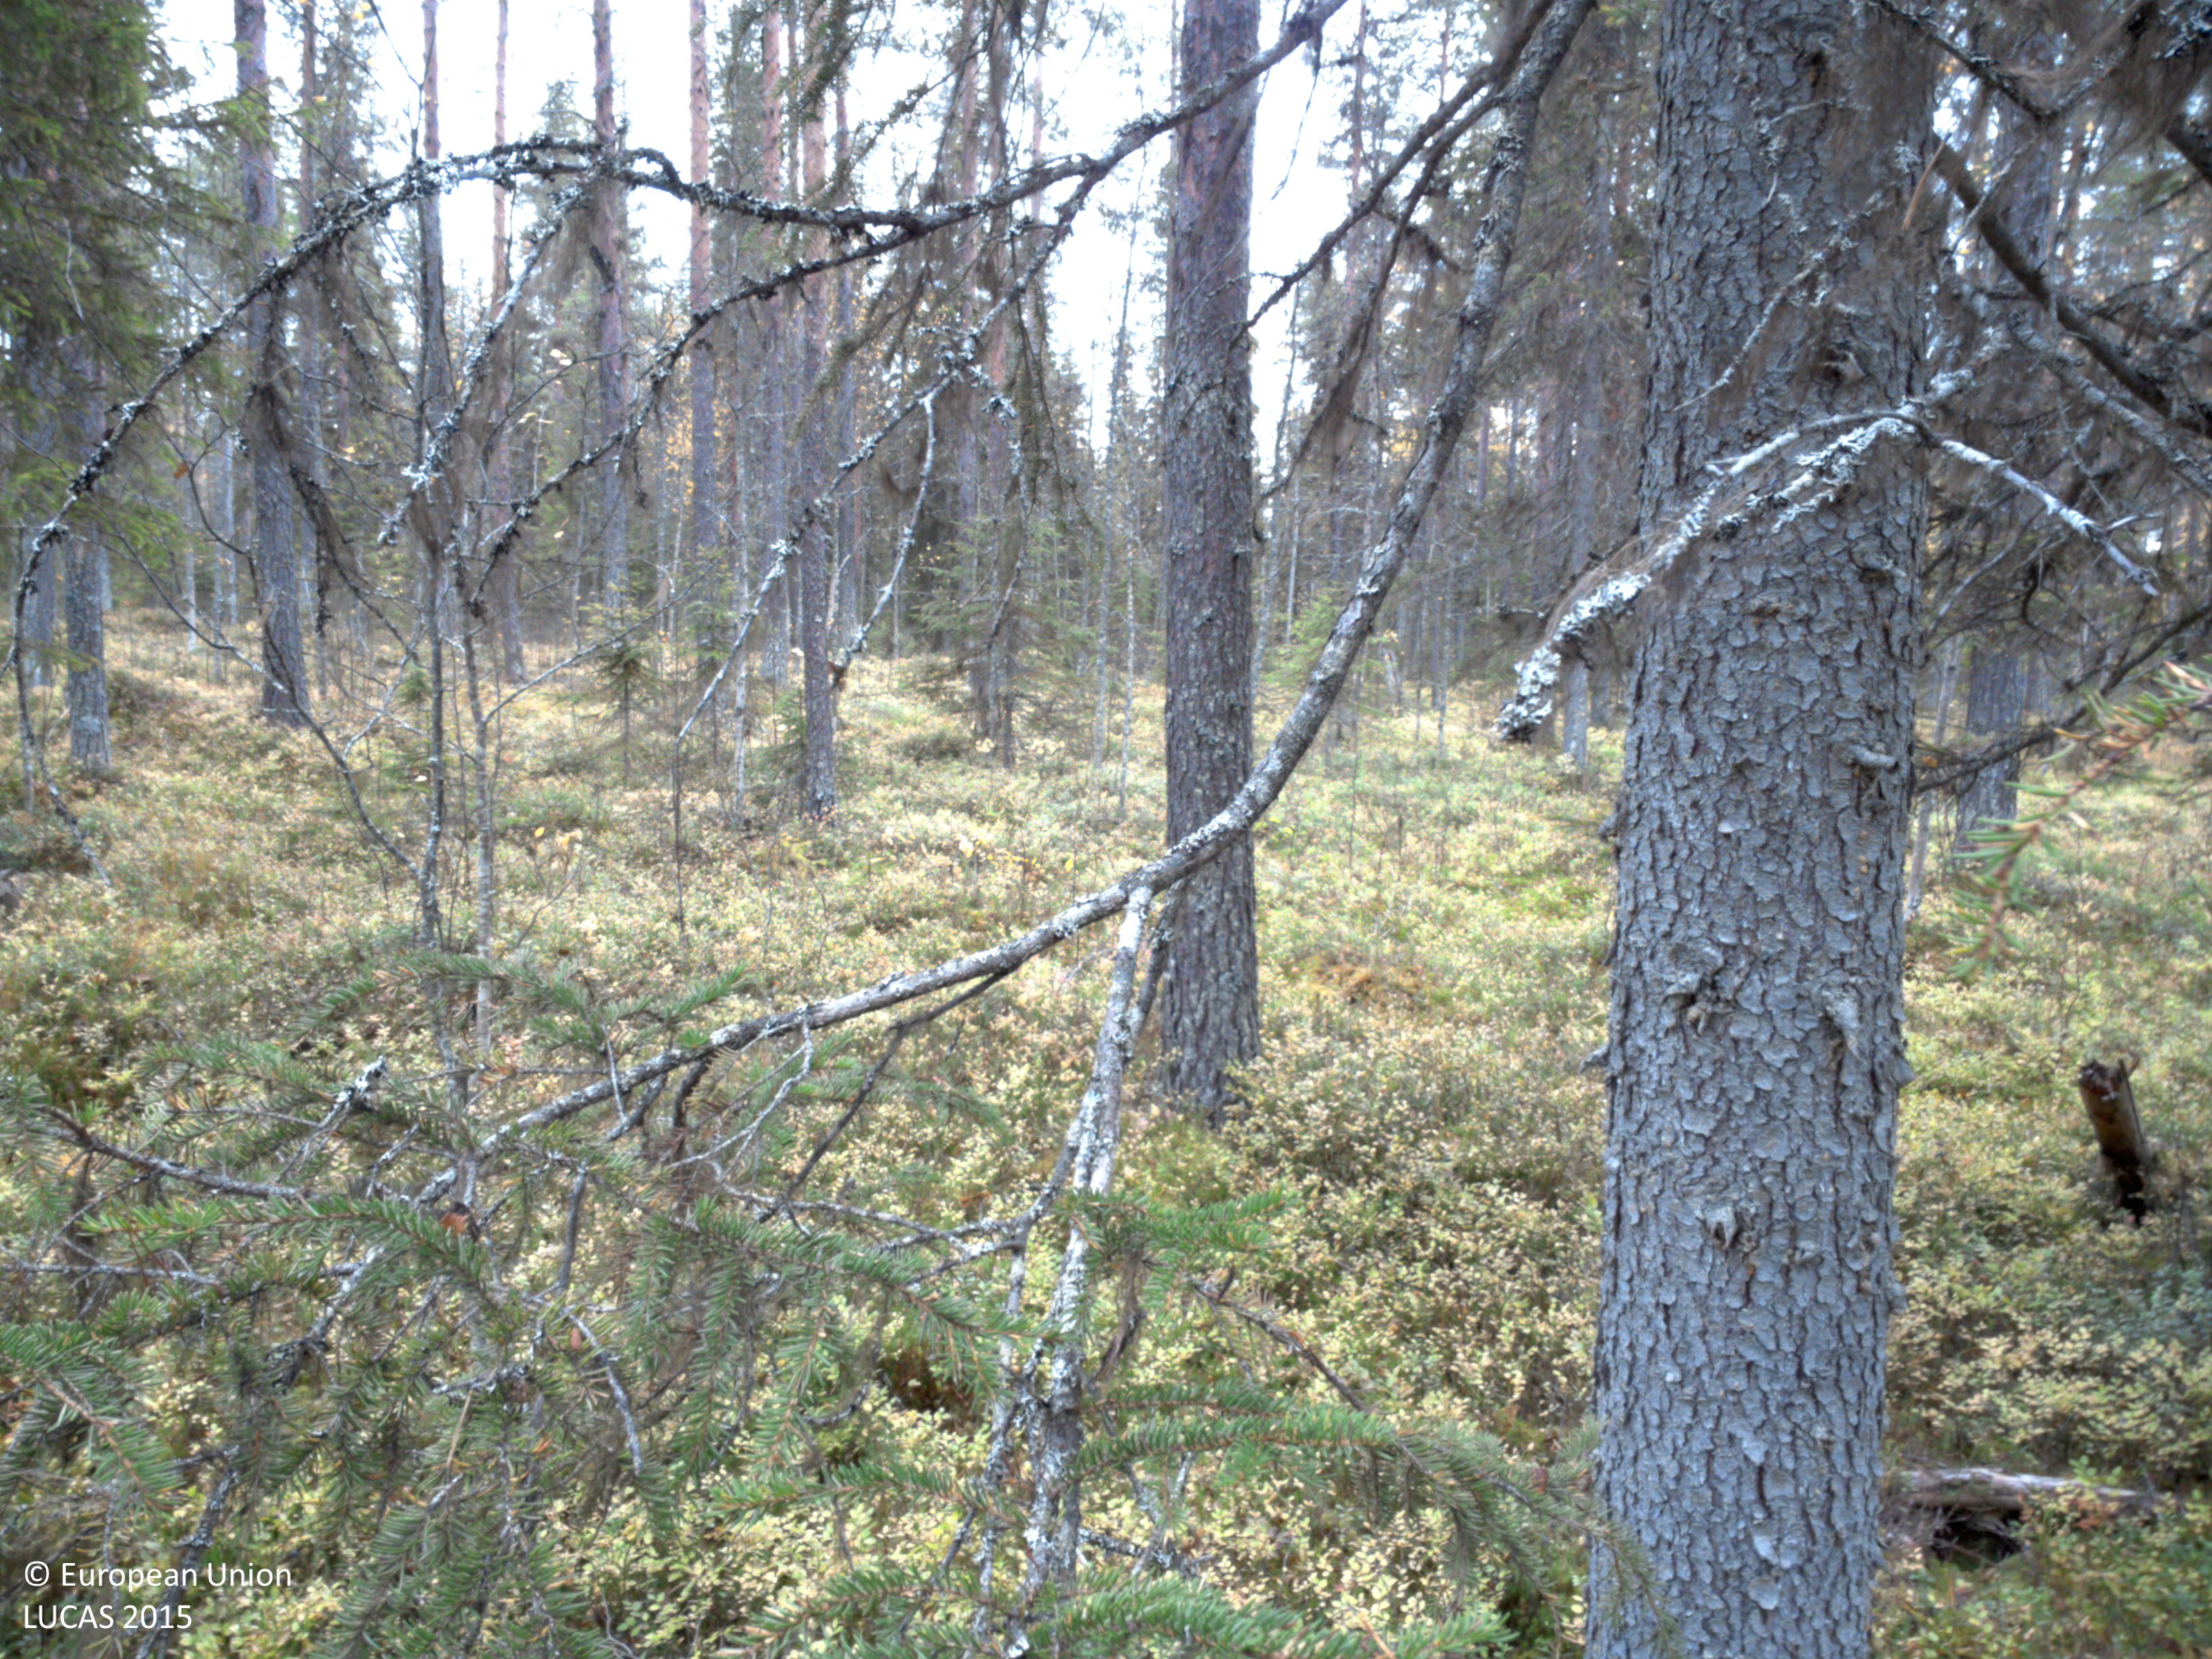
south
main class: Woodland
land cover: Spruce dominated coniferous woodland
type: boreal forest
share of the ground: > 75 %
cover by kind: coniferous forest trees 70 %, shrubs 20 %, broadleaved forest trees 5 %, lichens and mosses 5 %
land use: Forestry
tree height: > 5 m
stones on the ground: < 10 %
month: October
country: SE
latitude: 64.9494
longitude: 18.1981
